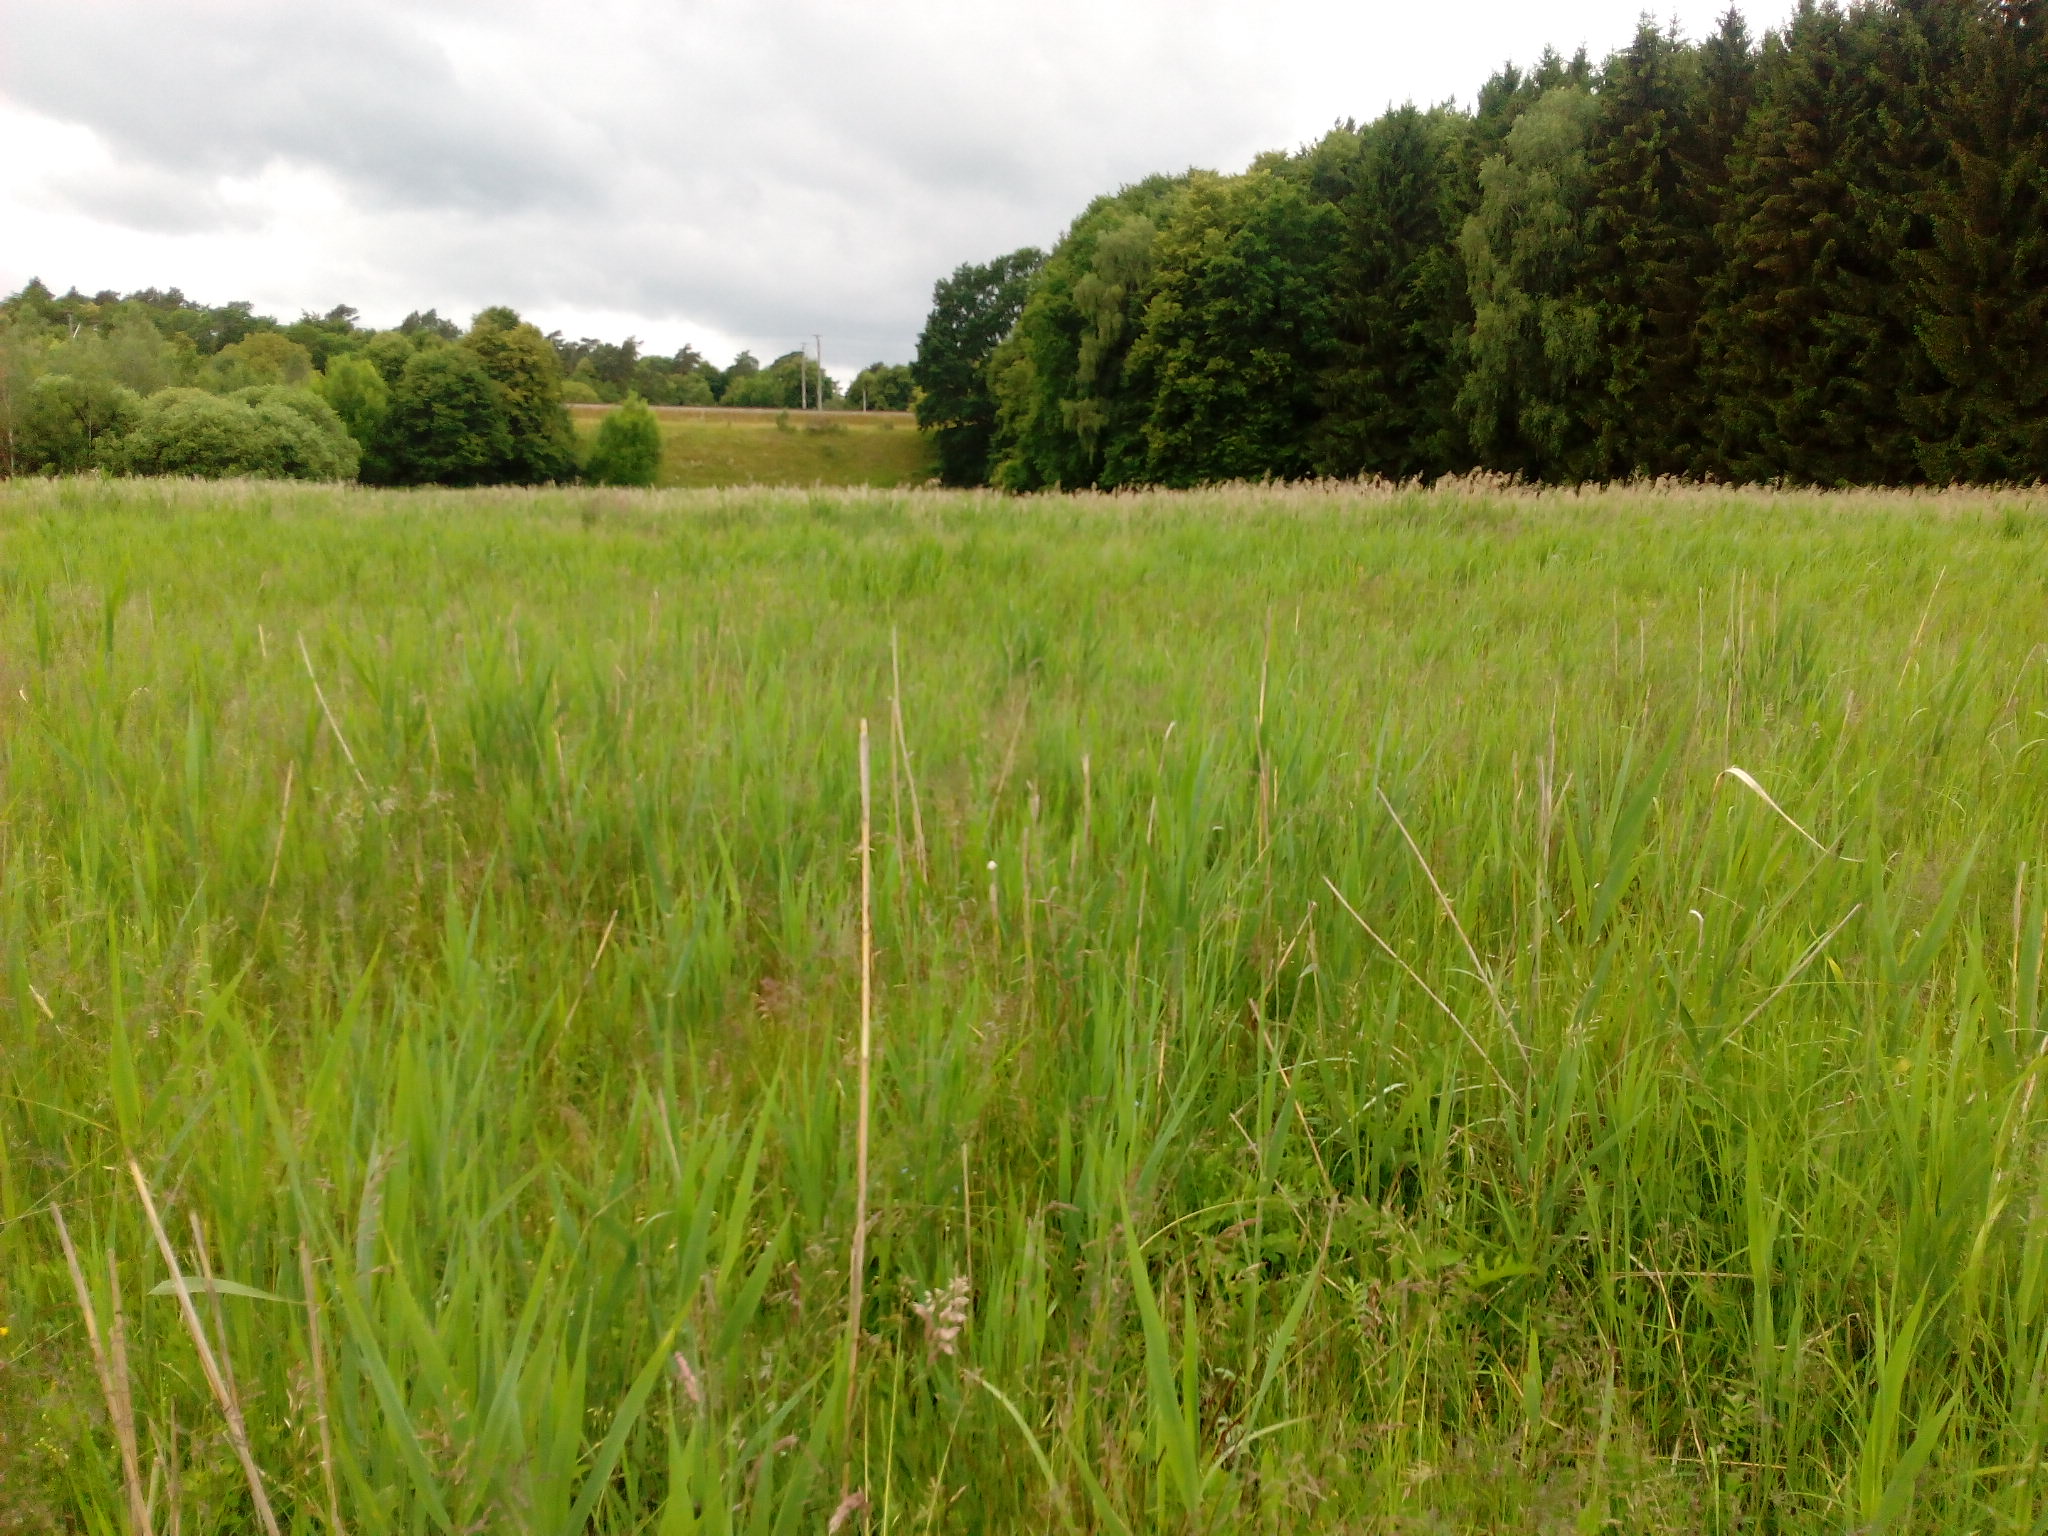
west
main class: Grassland
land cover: Grassland without tree/shrub cover
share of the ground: > 75 %
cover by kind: herbaceous plants 100 %
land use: Agriculture (excluding fallow land and kitchen gardens)
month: June
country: DE
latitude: 53.1084
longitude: 13.1815
